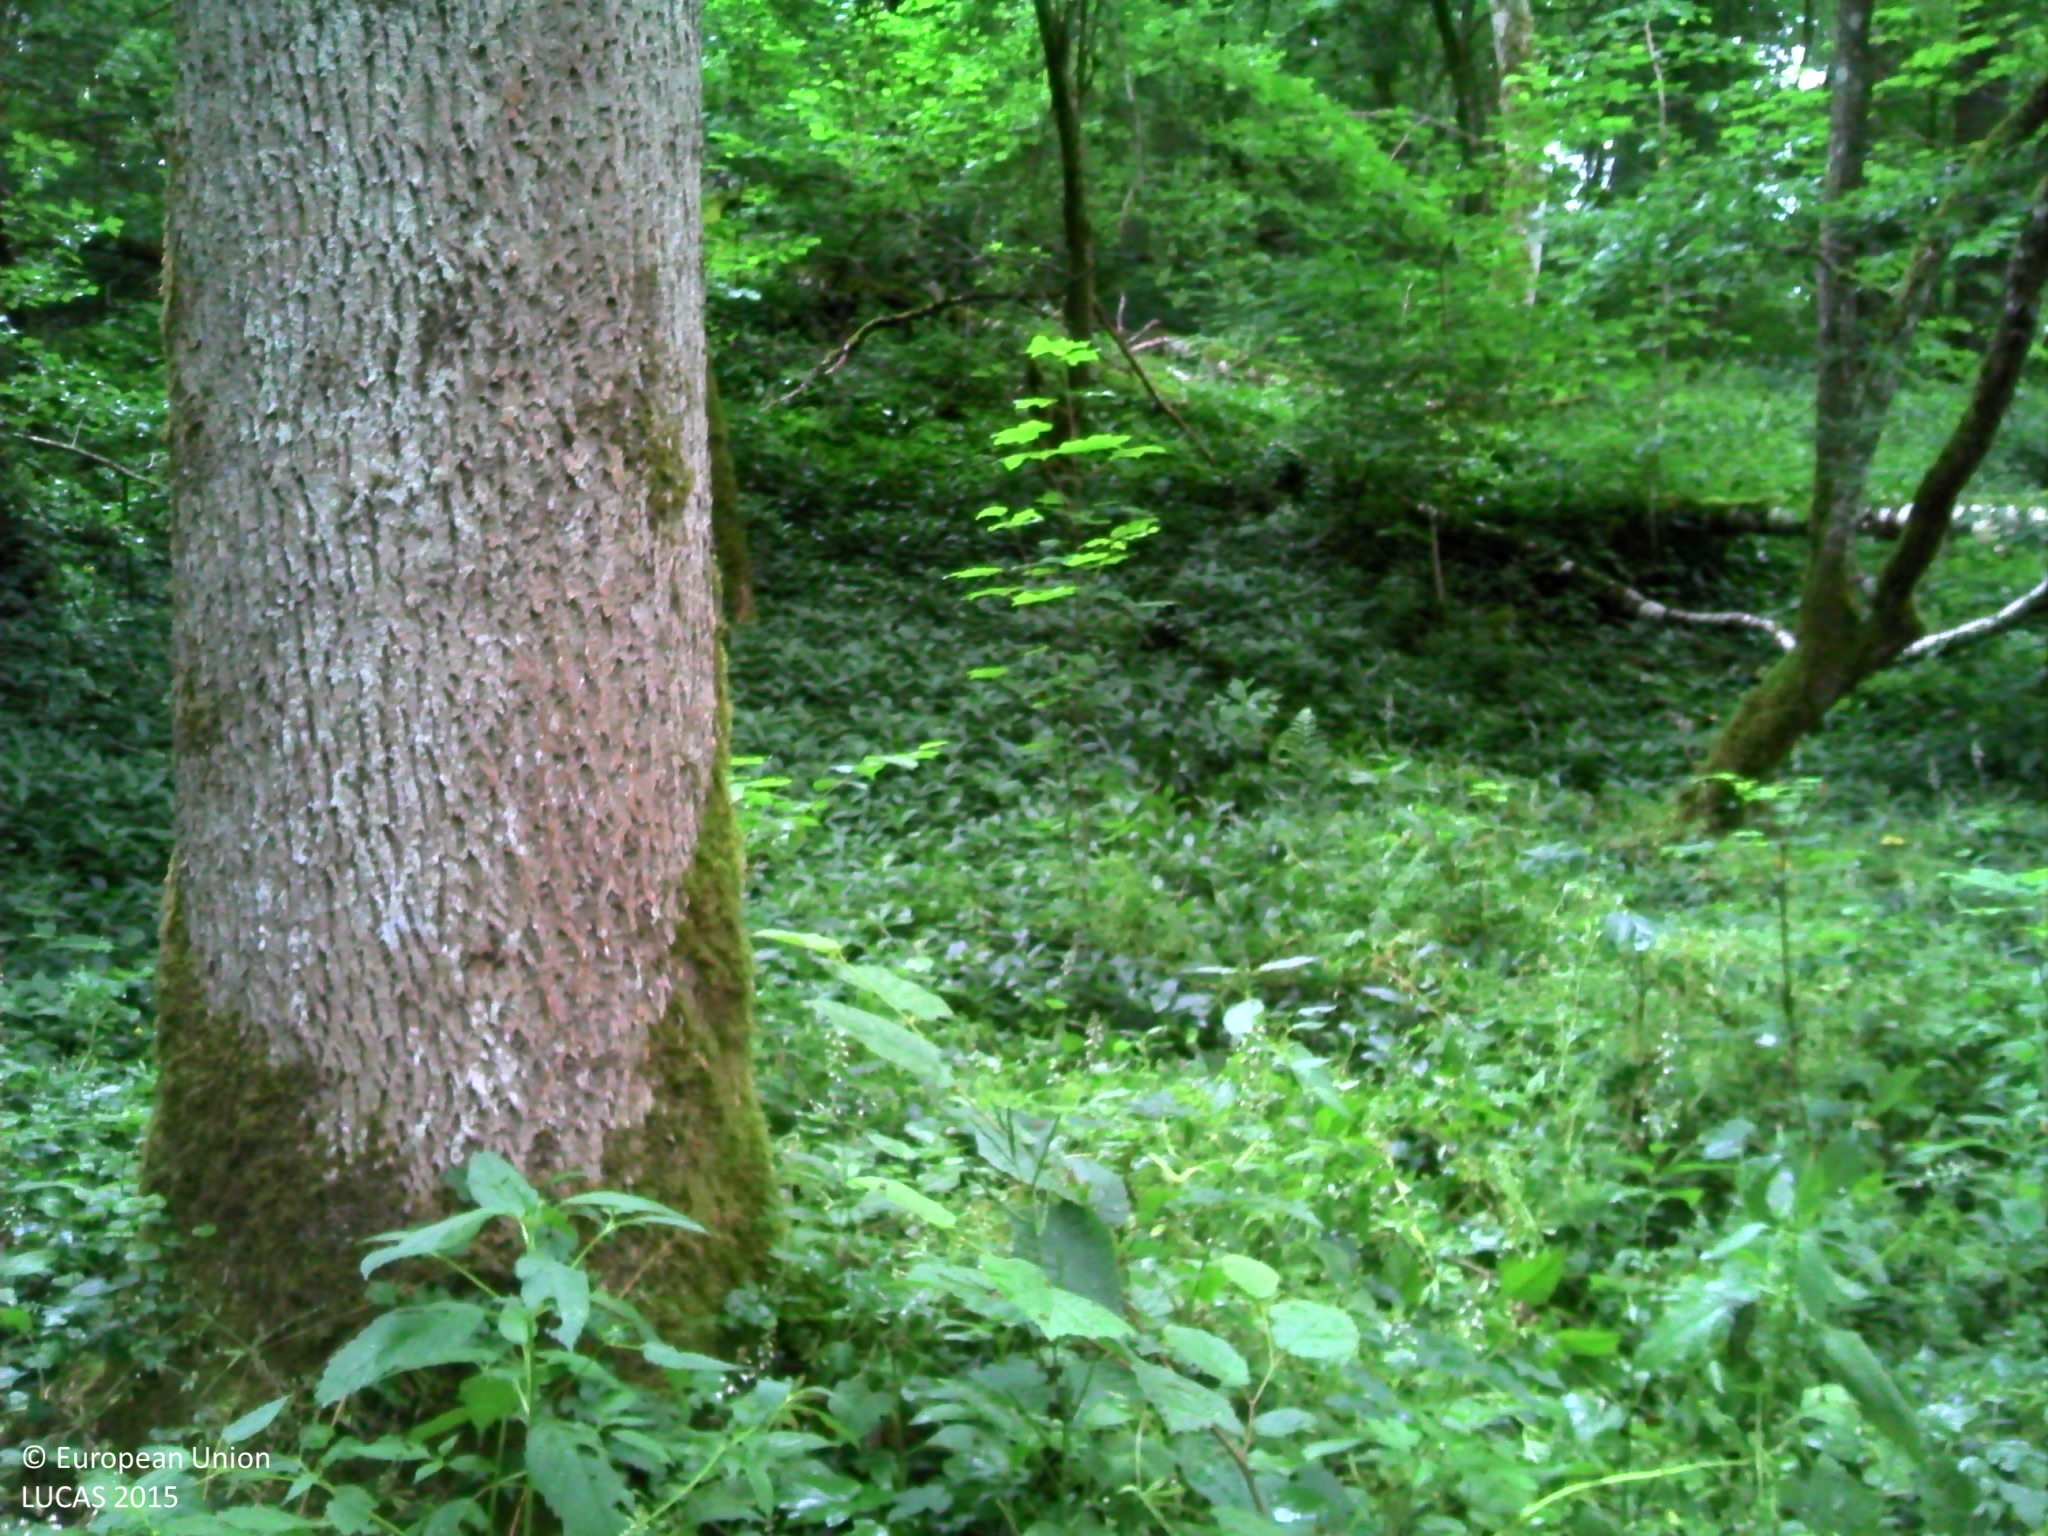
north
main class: Woodland
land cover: Broadleaved woodland
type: mesophytic deciduous forest
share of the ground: > 75 %
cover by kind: broadleaved forest trees 100 %
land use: Forestry
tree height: > 5 m
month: July
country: BE
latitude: 50.2032
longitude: 4.6584
